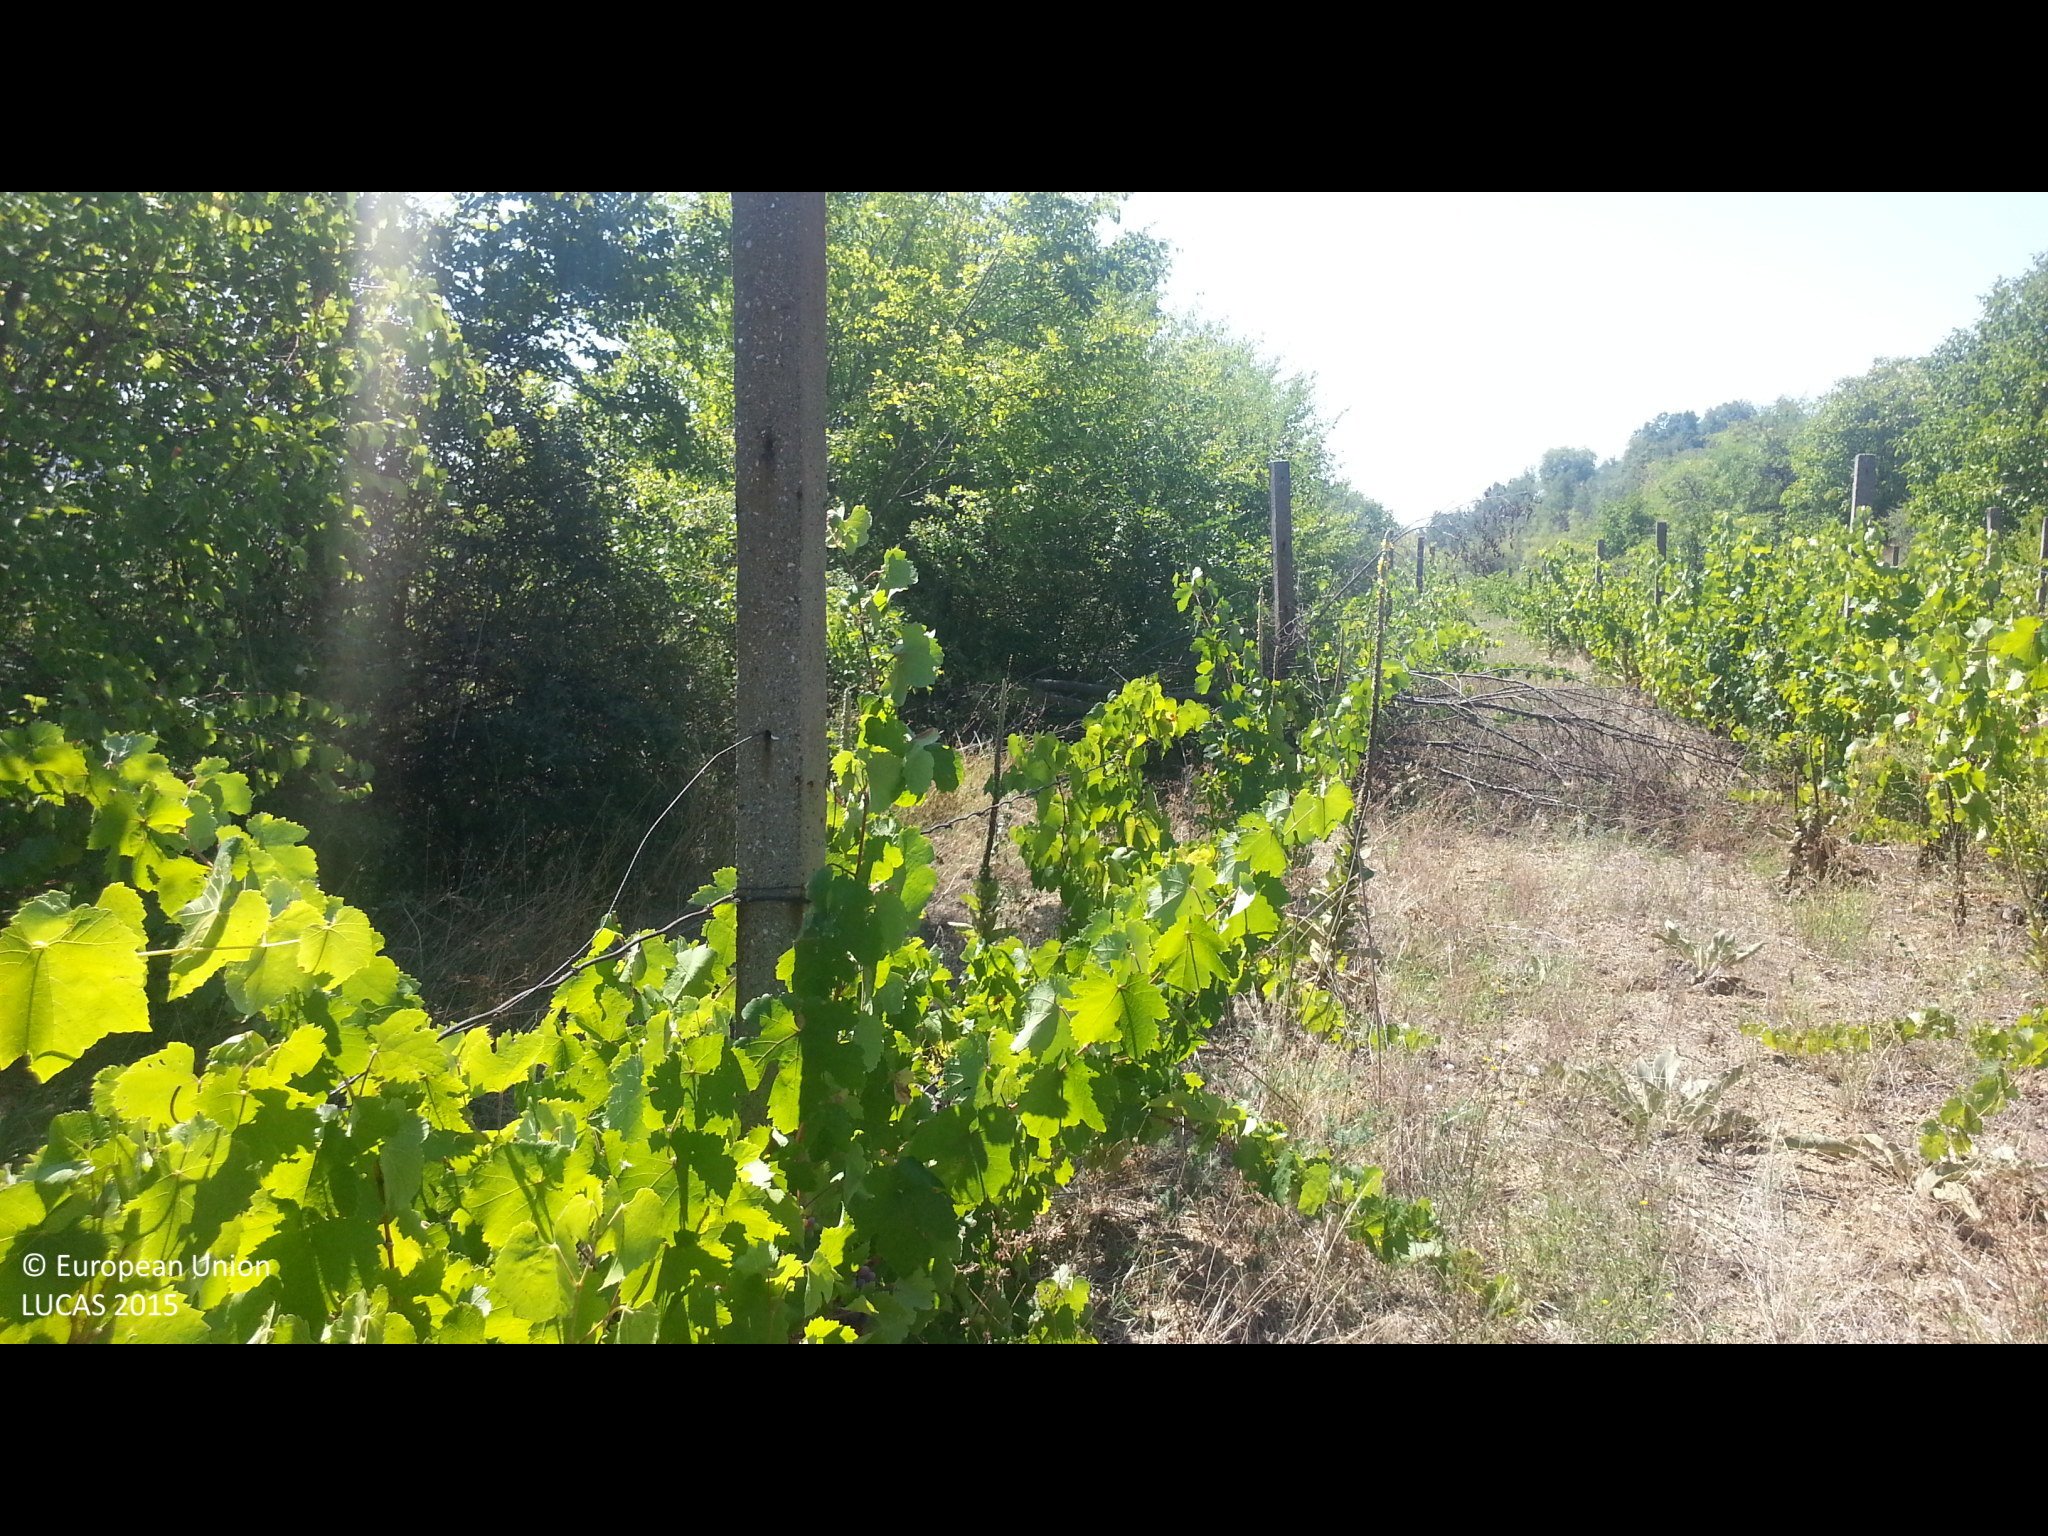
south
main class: Cropland
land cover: Vineyards
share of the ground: 25 - 50 %
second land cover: Spontaneously vegetated surfaces
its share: 50 - 75 %
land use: Agriculture (excluding fallow land and kitchen gardens)
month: September
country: BG
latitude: 42.1726
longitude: 23.0386
